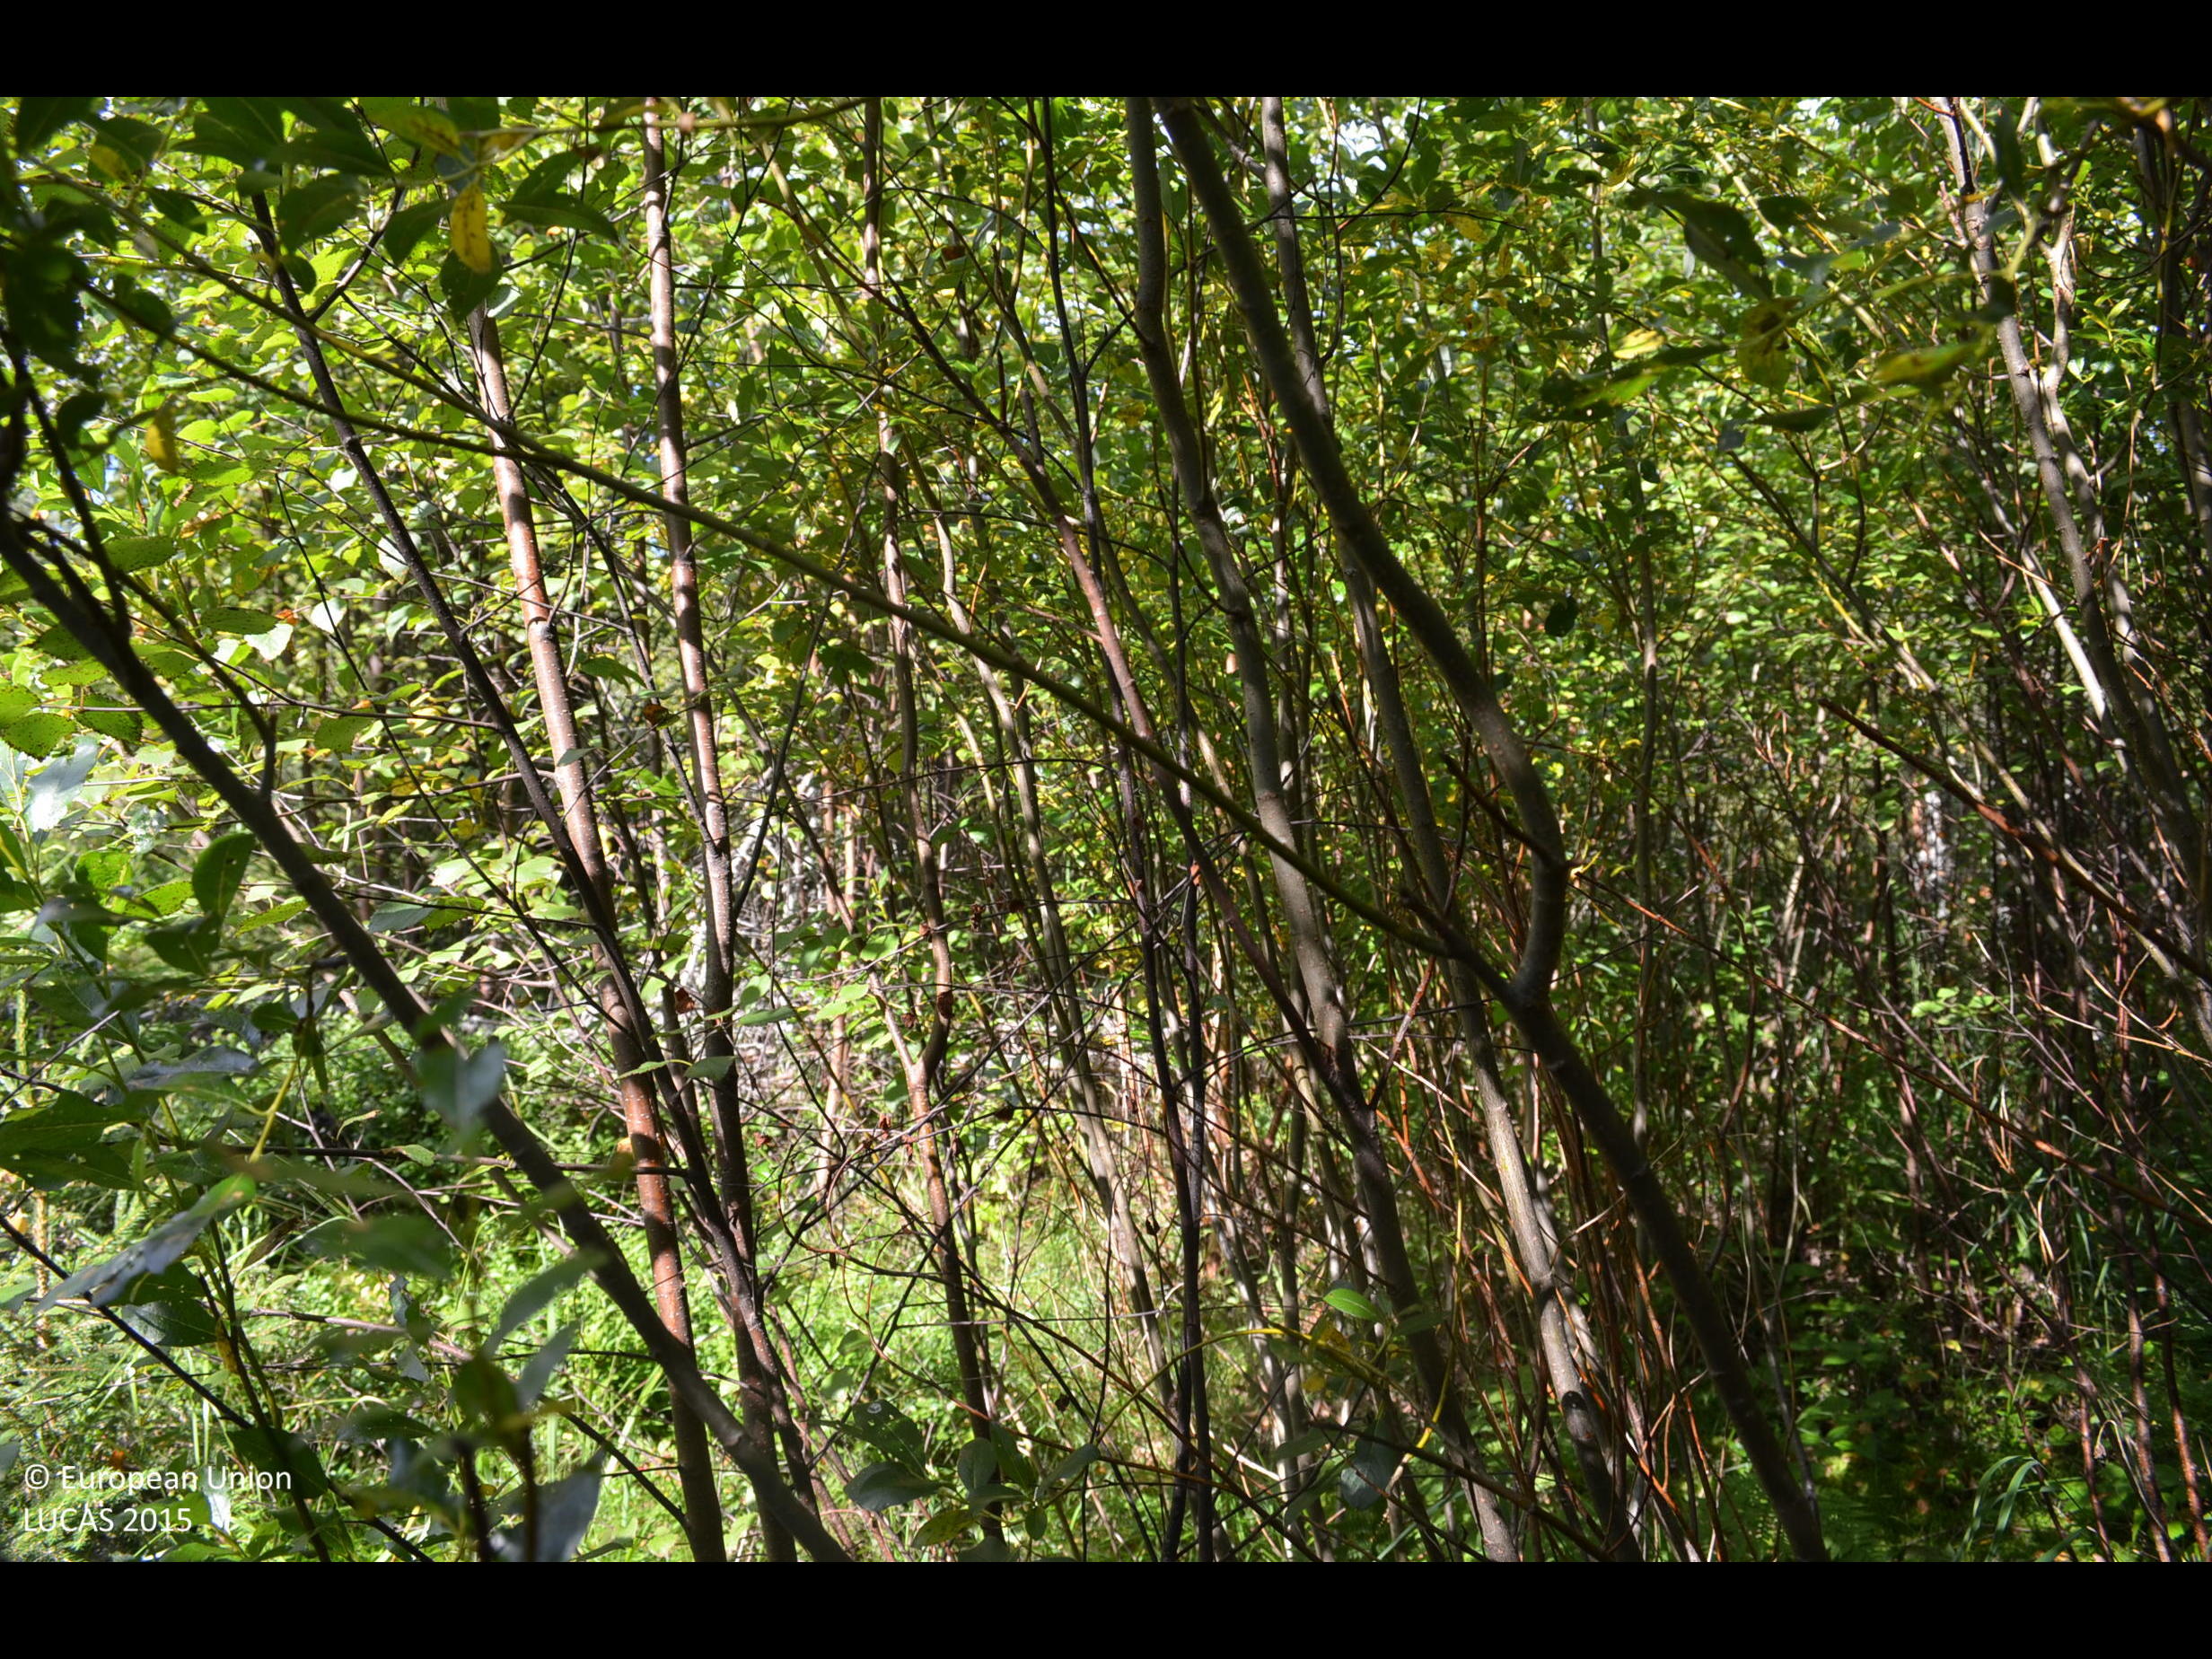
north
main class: Artificial land
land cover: Other artificial areas
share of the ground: > 75 %
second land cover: Broadleaved woodland
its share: > 75 %
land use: Electricity, gas and thermal power distribution
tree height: < 5 m
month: August
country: FI
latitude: 62.0643
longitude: 24.1893
